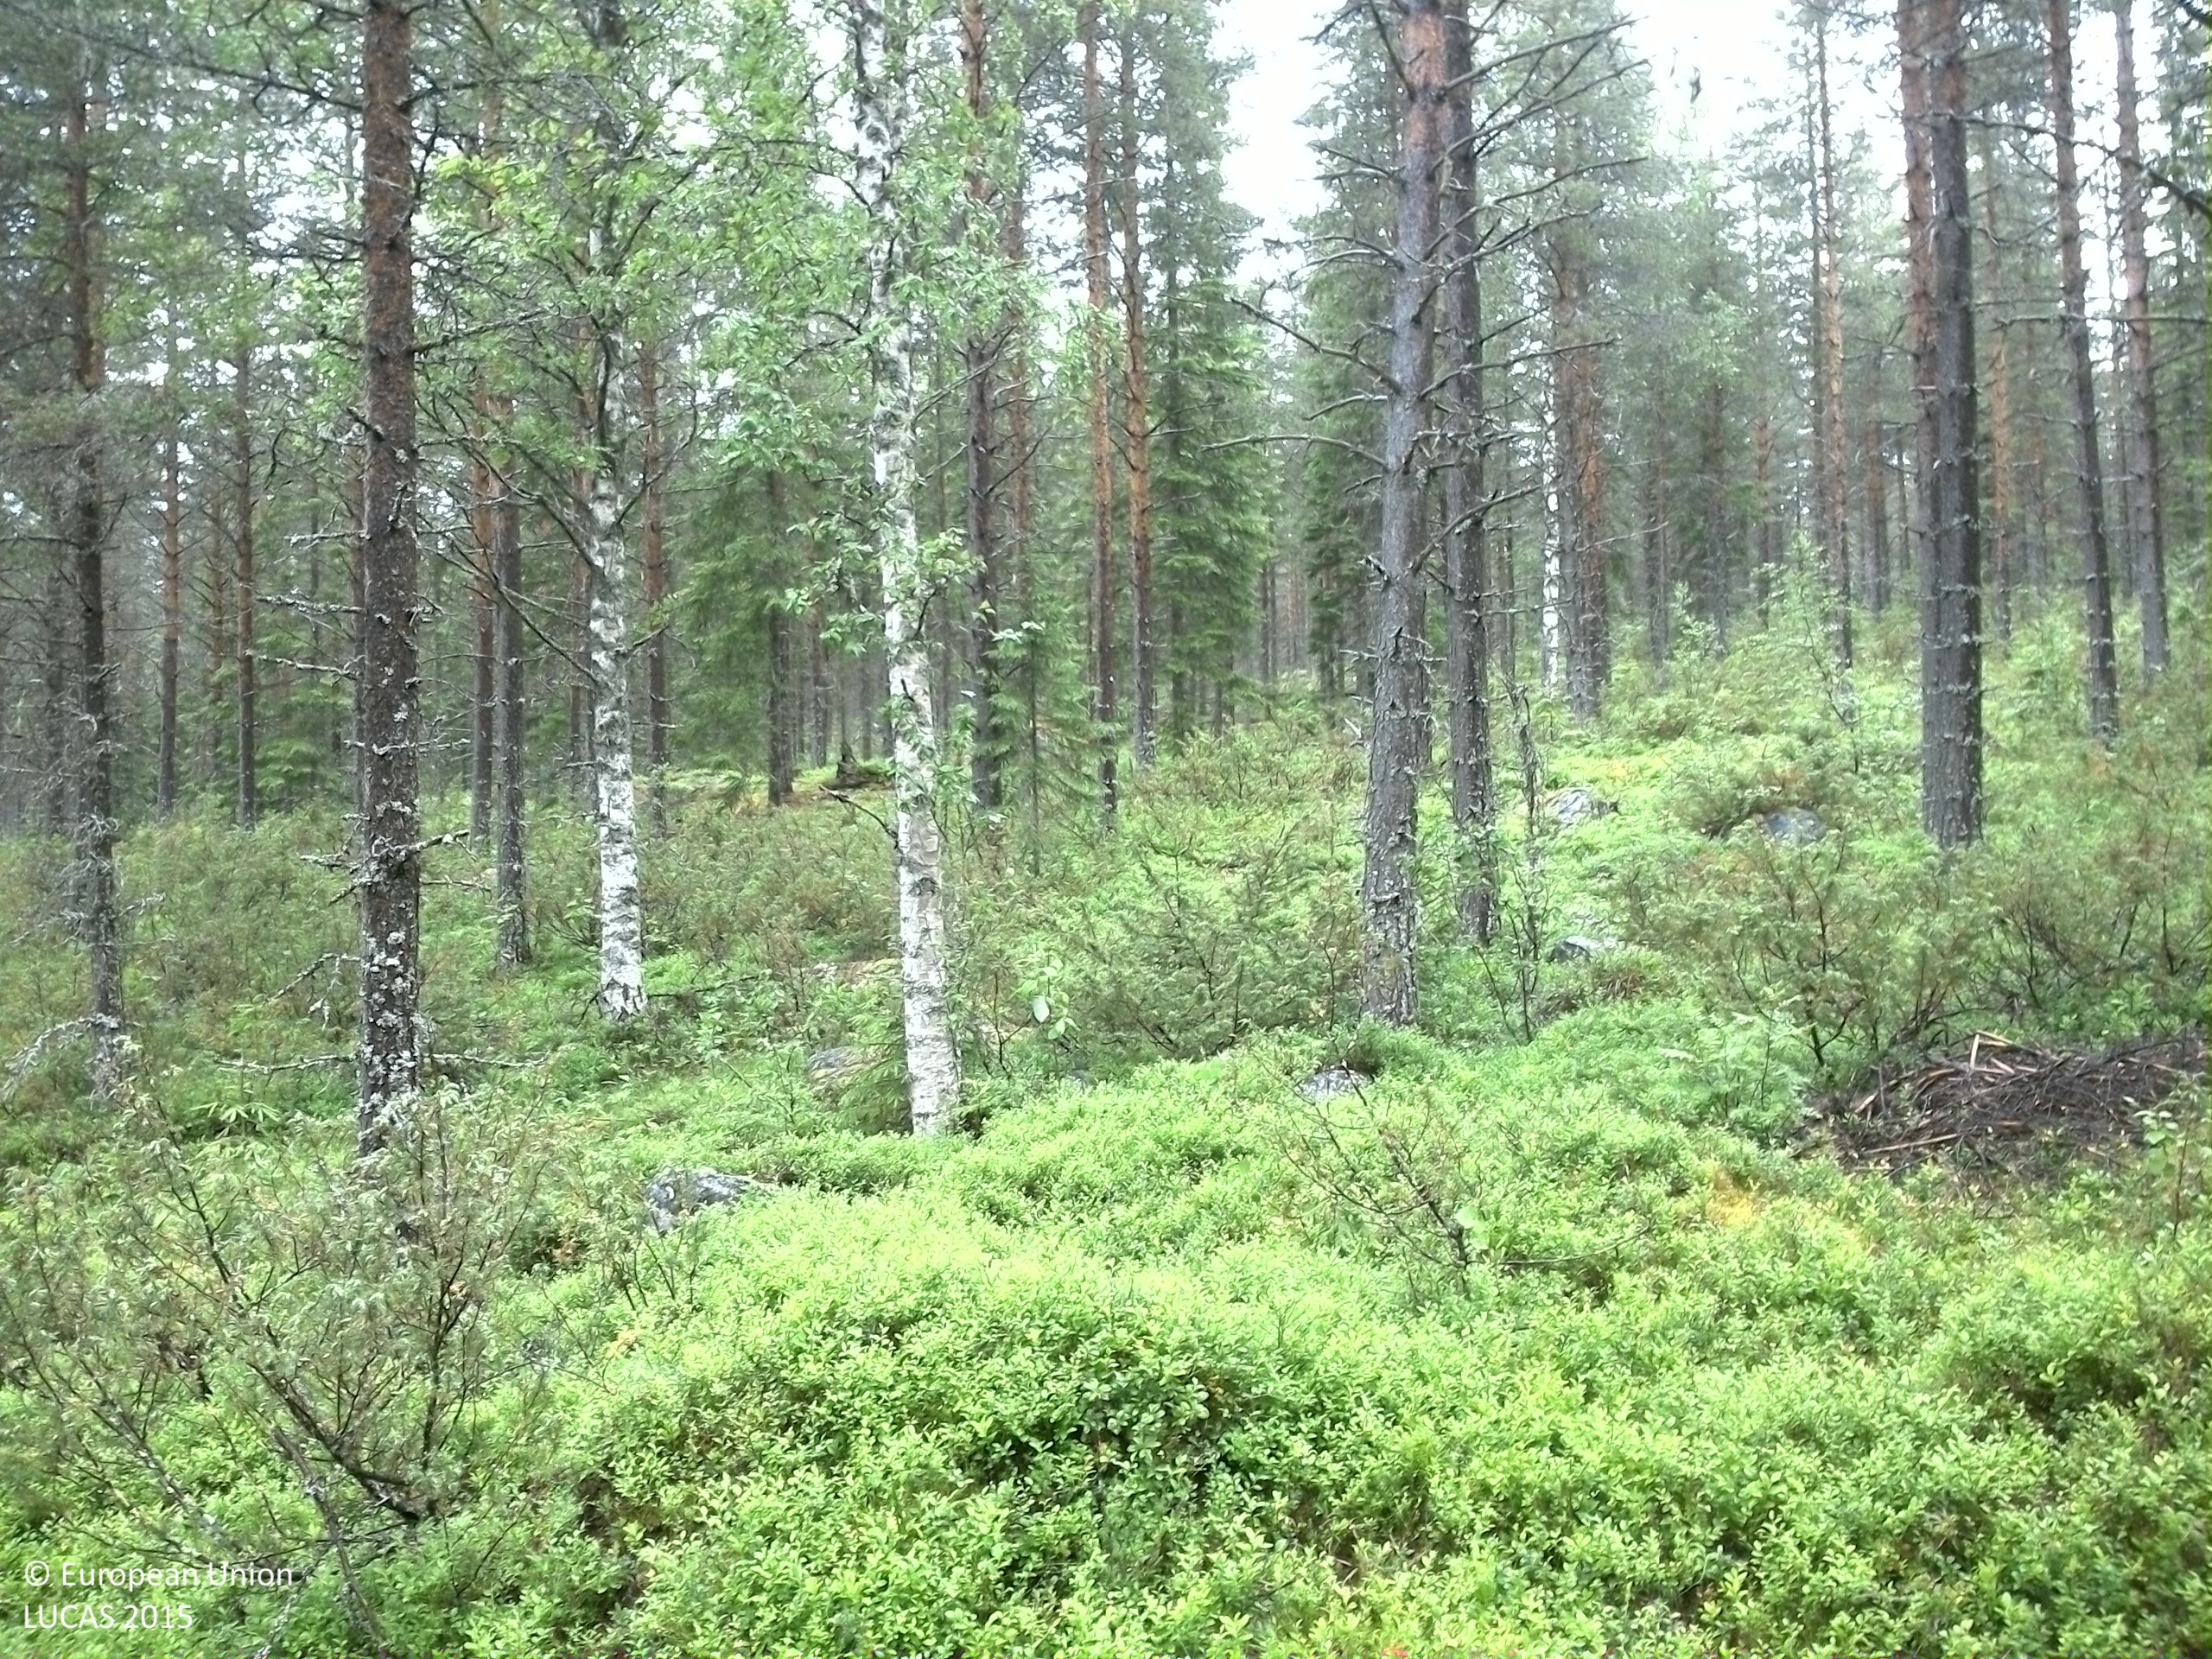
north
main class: Woodland
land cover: Pine dominated mixed woodland
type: boreal forest
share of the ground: 50 - 75 %
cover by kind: coniferous forest trees 40 %, broadleaved forest trees 20 %, shrubs 20 %, herbaceous plants 10 %, lichens and mosses 10 %
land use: Forestry
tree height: > 5 m
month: July
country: SE
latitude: 63.6854
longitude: 17.3121
